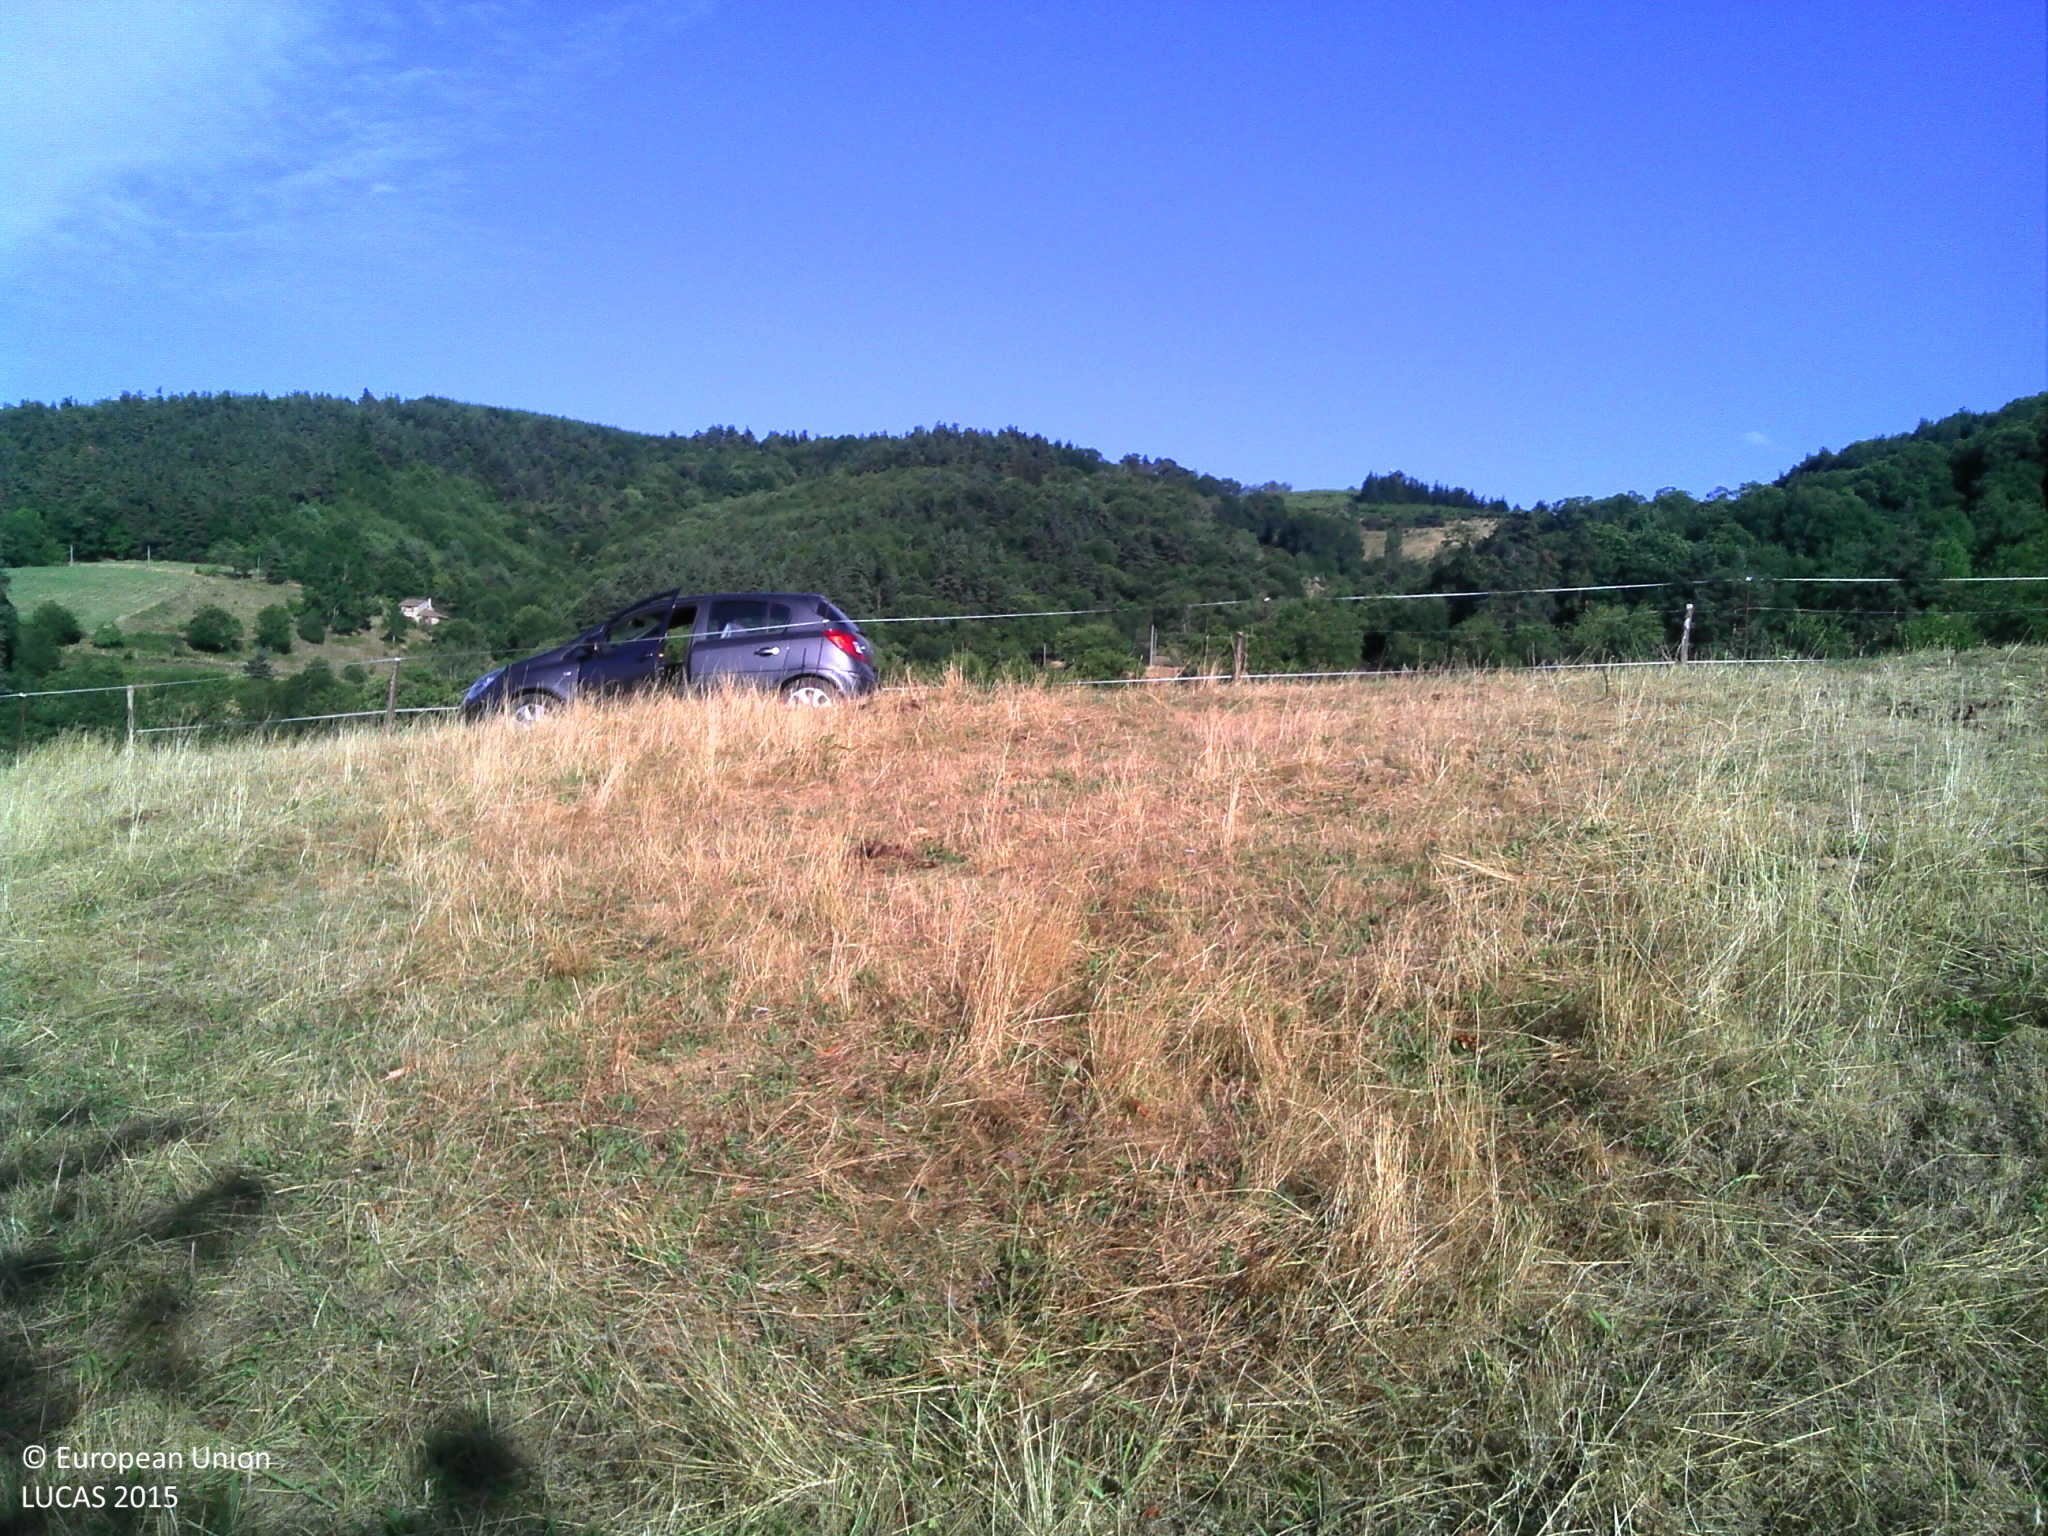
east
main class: Grassland
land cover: Grassland without tree/shrub cover
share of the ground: > 75 %
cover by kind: herbaceous plants 100 %
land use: Agriculture (excluding fallow land and kitchen gardens)
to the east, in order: Grassland without tree/shrub cover; Fences; Paved roads, cycling and walking lanes; Fences; Grassland without tree/shrub cover; Fences; Paved roads, cycling and walking lanes; Grassland without tree/shrub cover; Abandoned hedges; Fences; Grassland without tree/shrub cover; Electric lines; Fences; Temporary grasslands; Electric lines; Tracks; Grassland without tree/shrub cover
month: July
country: FR
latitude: 44.9504
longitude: 4.5932
